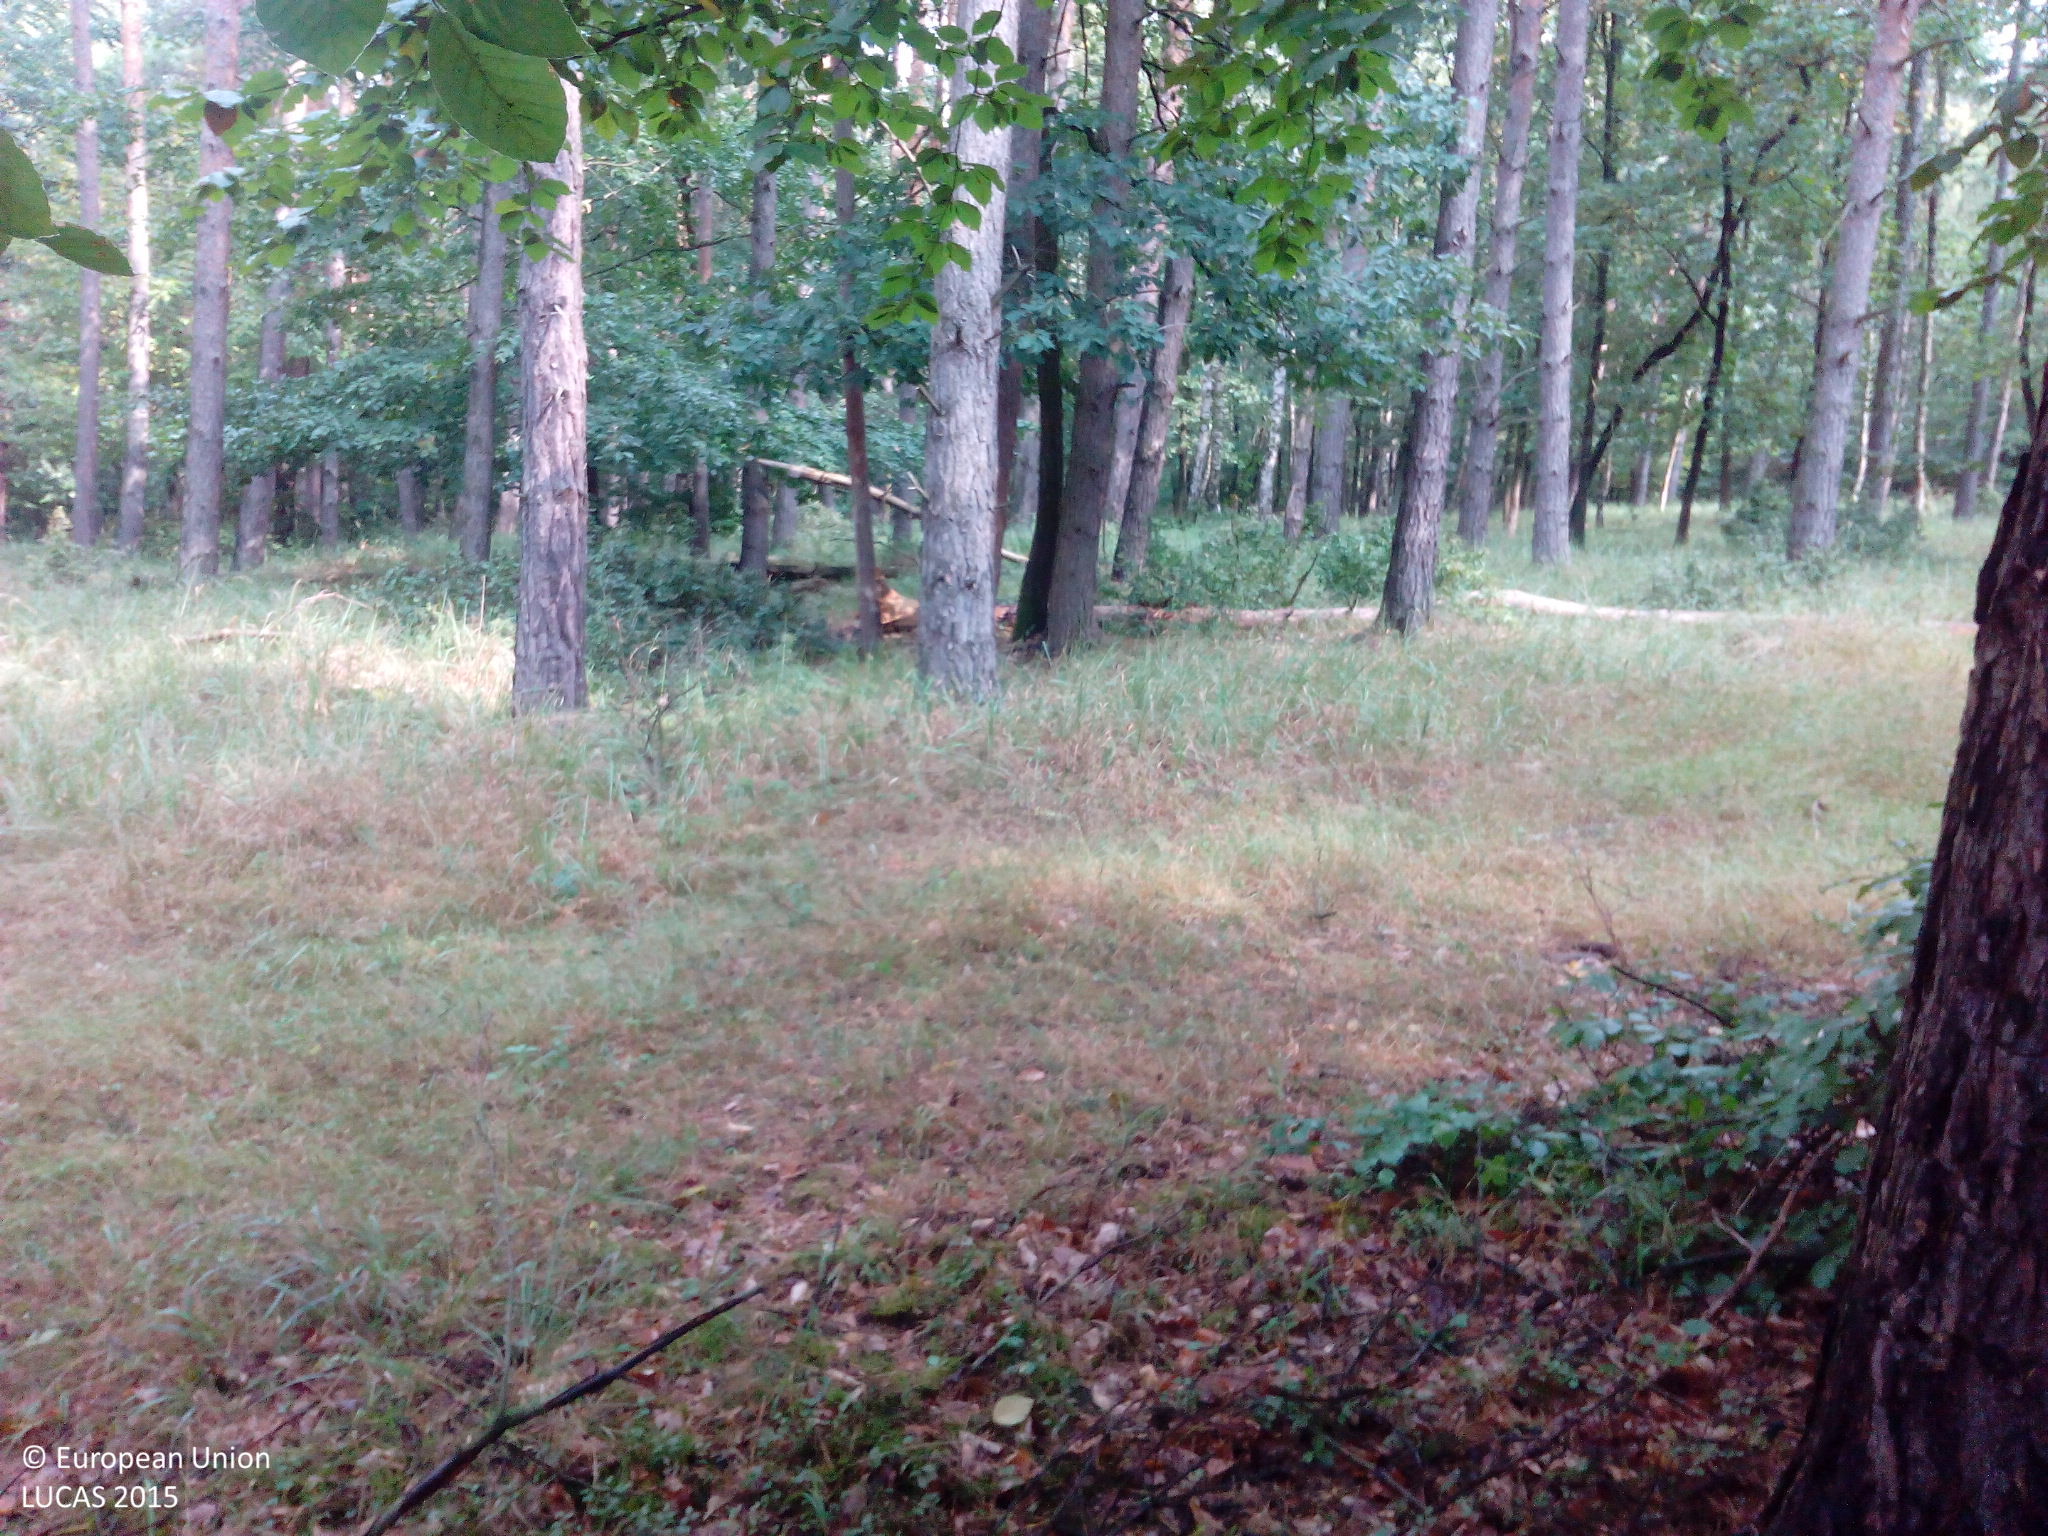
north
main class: Woodland
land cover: Other mixed woodland
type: hemiboreal forest and nemoral coniferous forest and mixed broadleaved-coniferous forest
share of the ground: > 75 %
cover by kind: coniferous forest trees 50 %, broadleaved forest trees 45 %, herbaceous plants 5 %
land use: Forestry
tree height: > 5 m
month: August
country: DE
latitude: 51.6665
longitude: 12.5589
